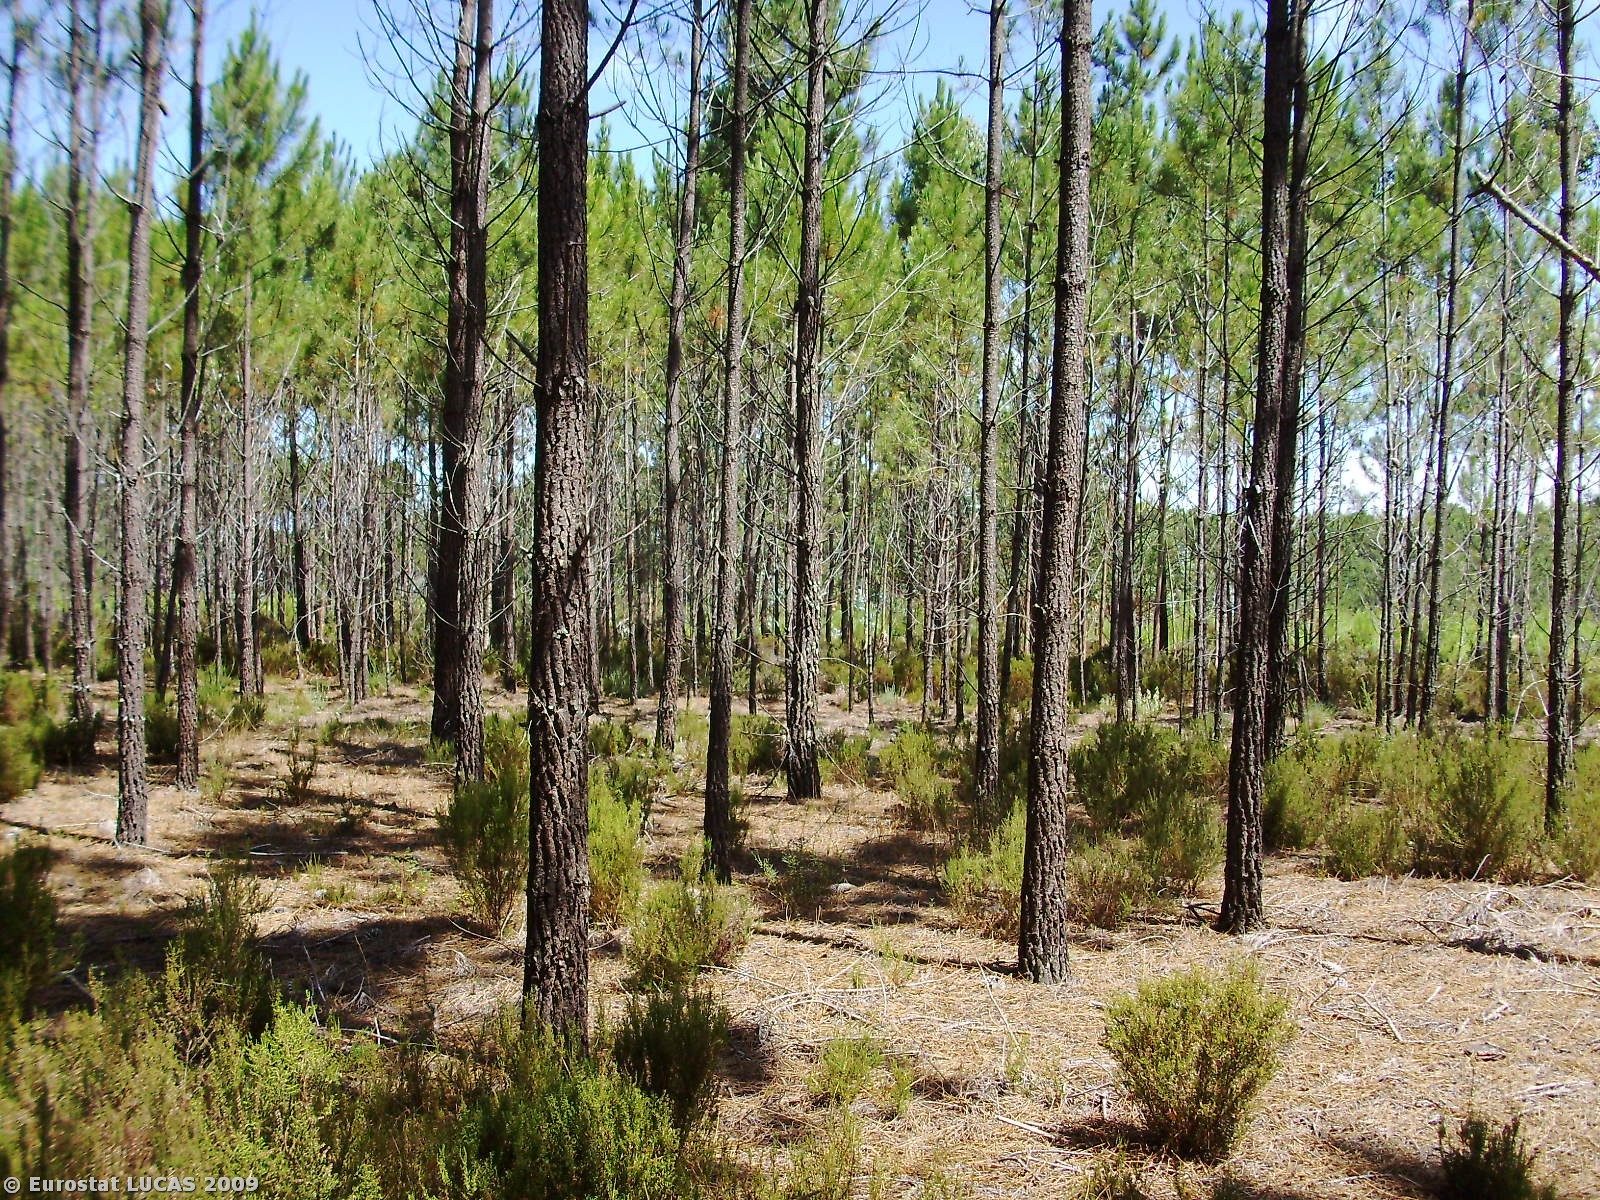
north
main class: Woodland
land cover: Coniferous woodland
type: coniferous forest of the mediterranean region
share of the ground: > 75 %
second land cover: Shrubland with sparse tree cover
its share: 10 - 25 %
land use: Forestry
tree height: > 5 m
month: July
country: PT
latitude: 39.7818
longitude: -8.8996
